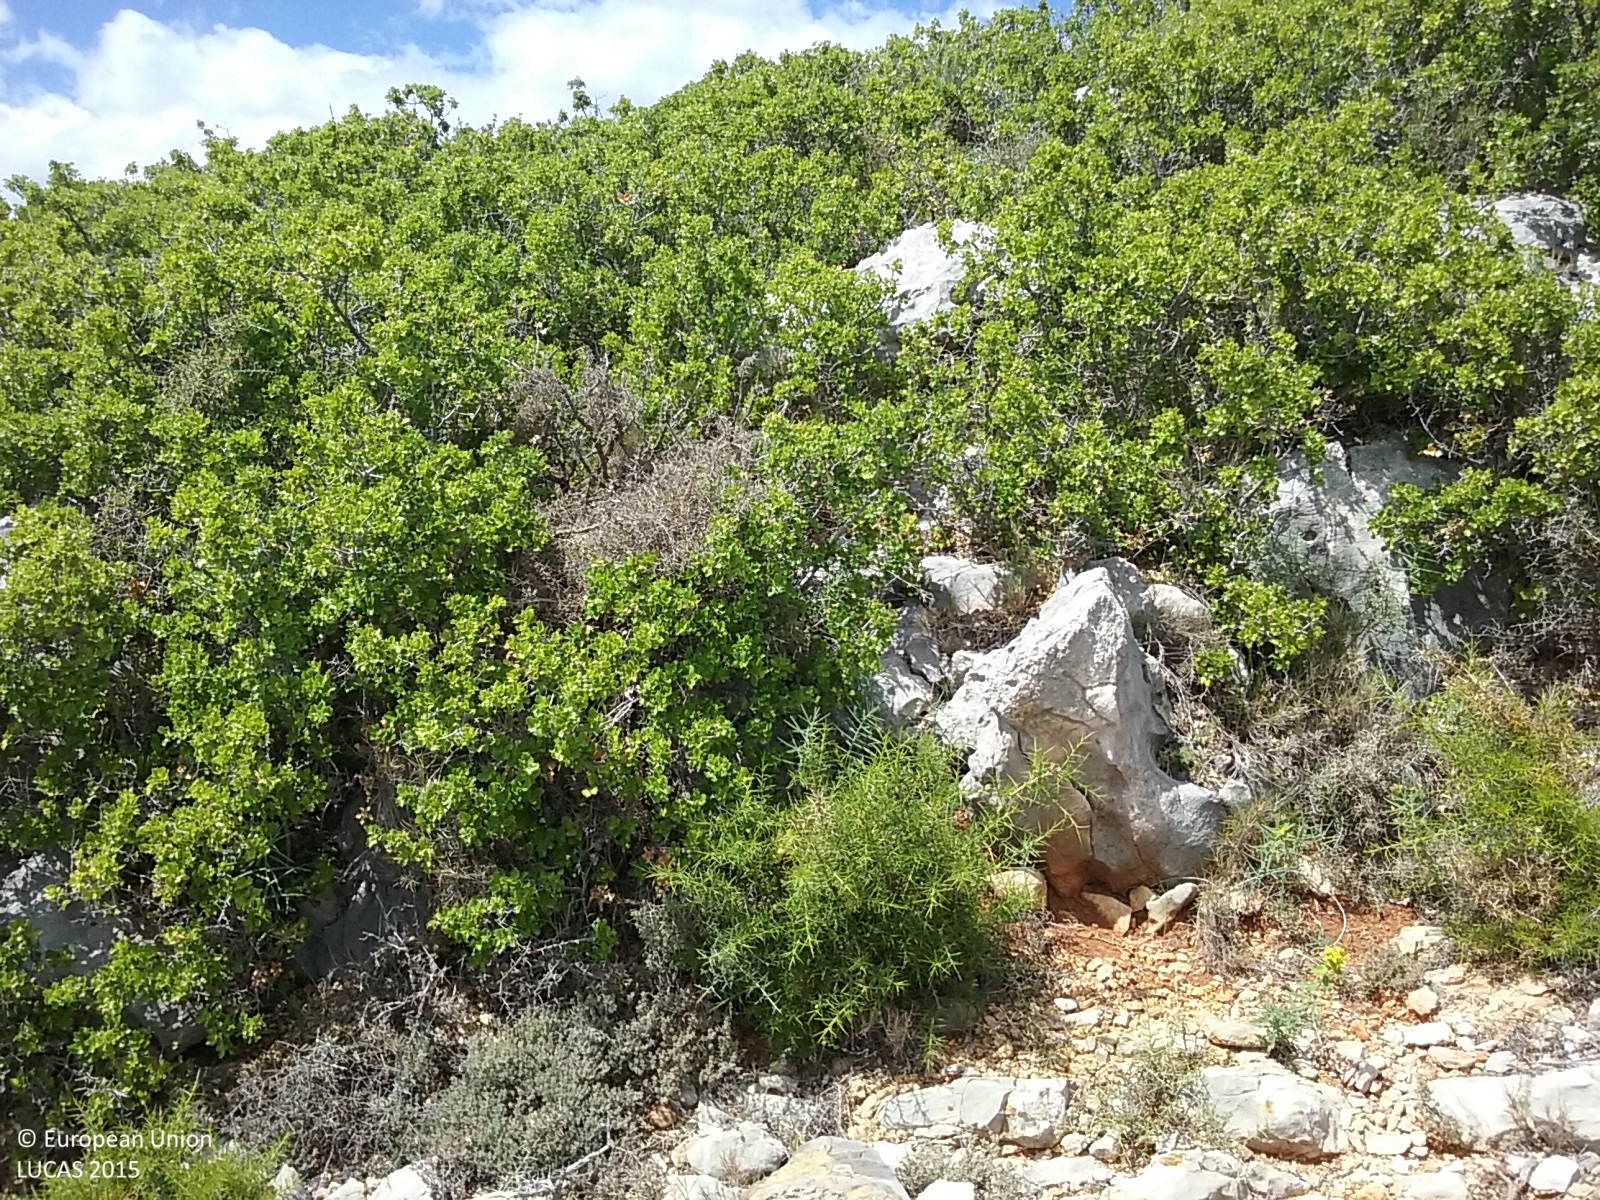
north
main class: Shrubland
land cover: Shrubland without tree cover
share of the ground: > 75 %
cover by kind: shrubs 90 %
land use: Semi-natural and natural areas not in use
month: May
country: ES
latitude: 40.3633
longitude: 0.0688
